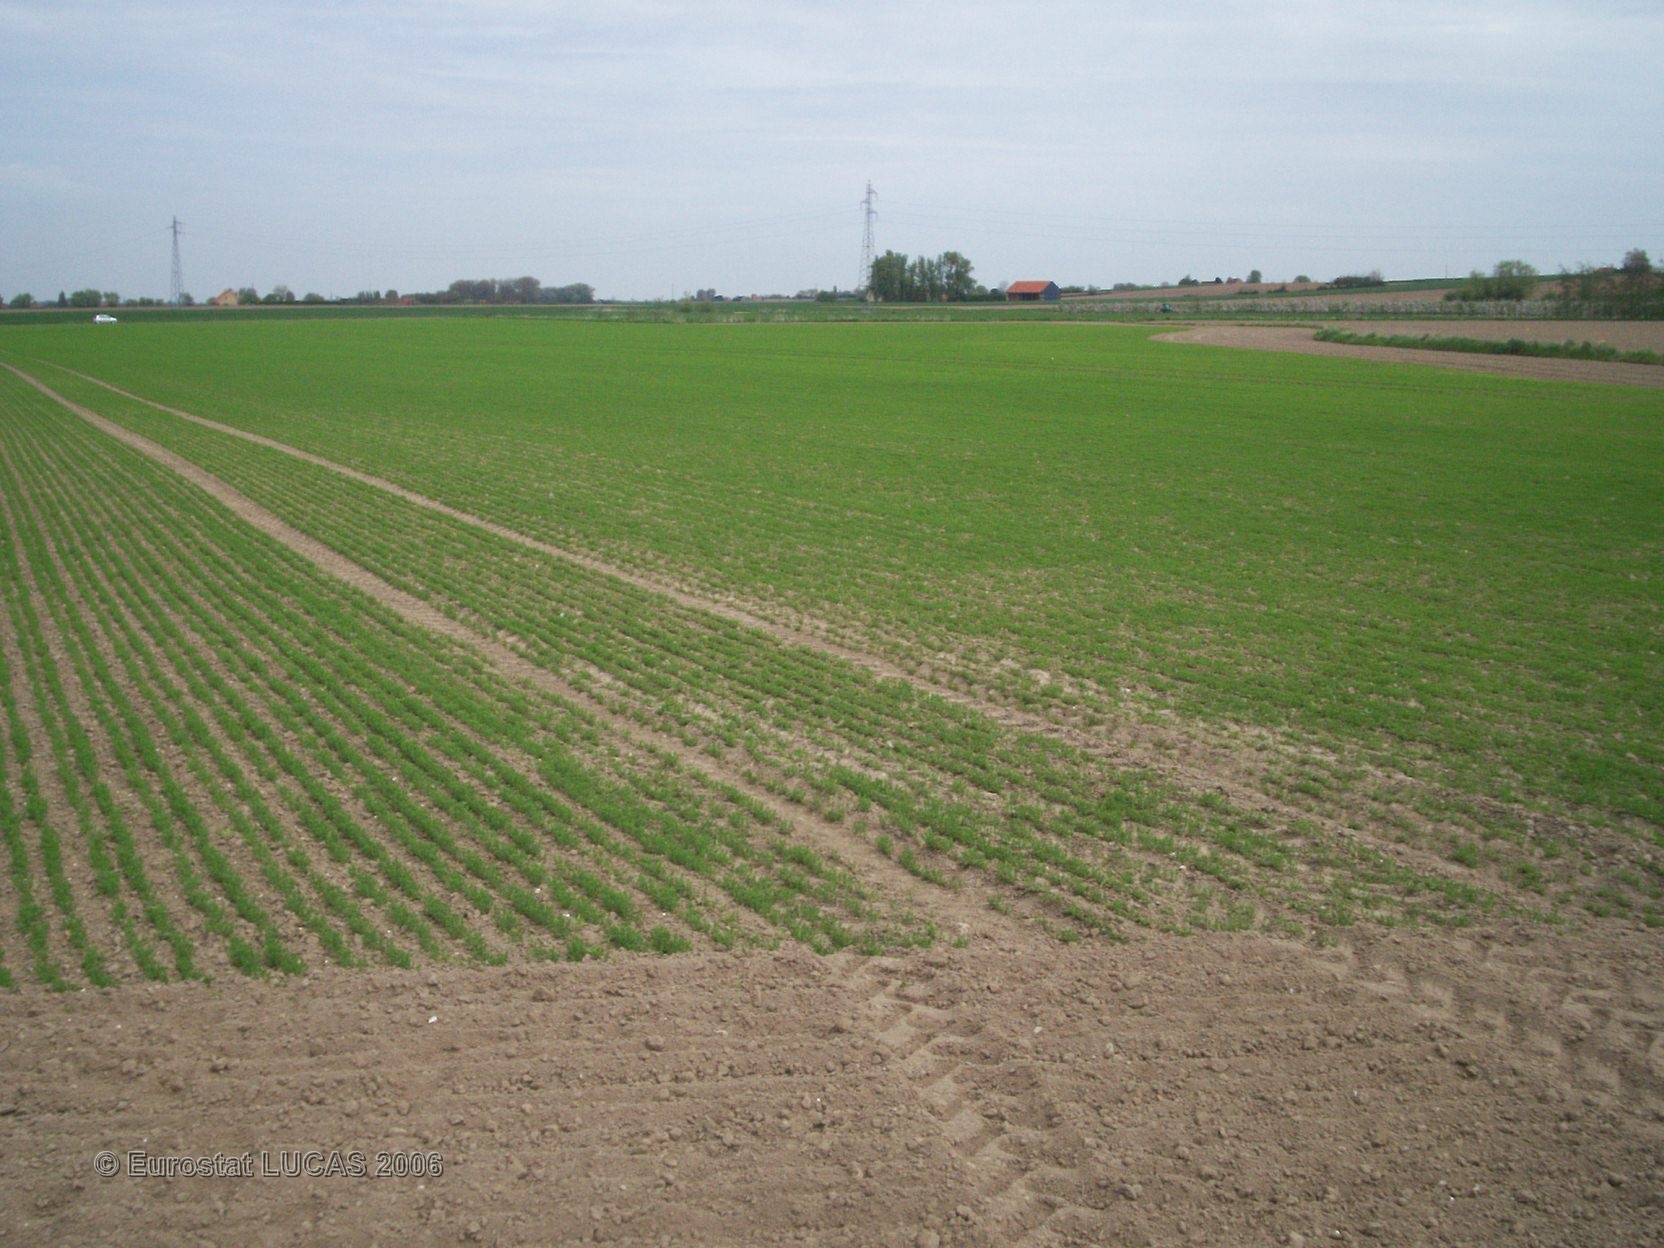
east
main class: Grassland
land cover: Grassland without tree/shrub cover
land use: Agriculture (excluding fallow land and kitchen gardens)
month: May
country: FR
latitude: 50.9382
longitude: 2.3444
